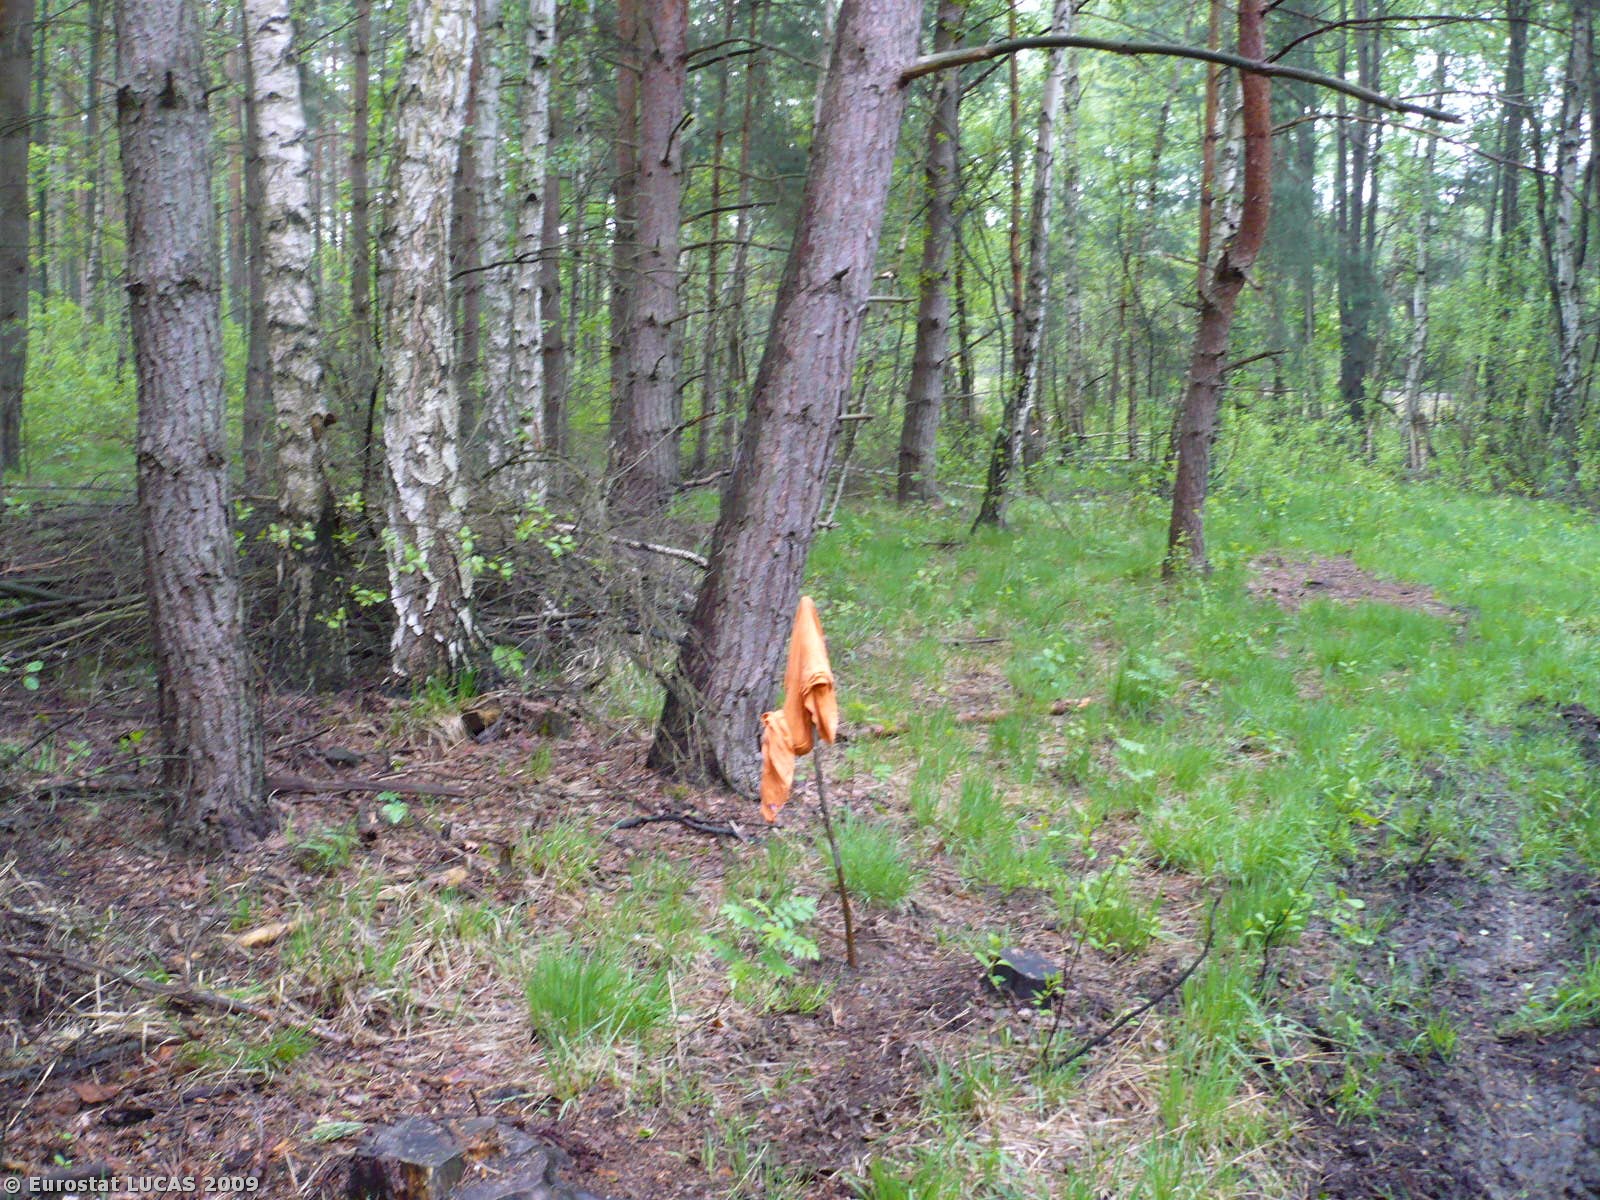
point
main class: Woodland
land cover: Coniferous woodland
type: hemiboreal forest and nemoral coniferous forest and mixed broadleaved-coniferous forest
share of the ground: > 75 %
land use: Forestry
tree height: > 5 m
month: May
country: PL
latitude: 51.9151
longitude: 15.3392
